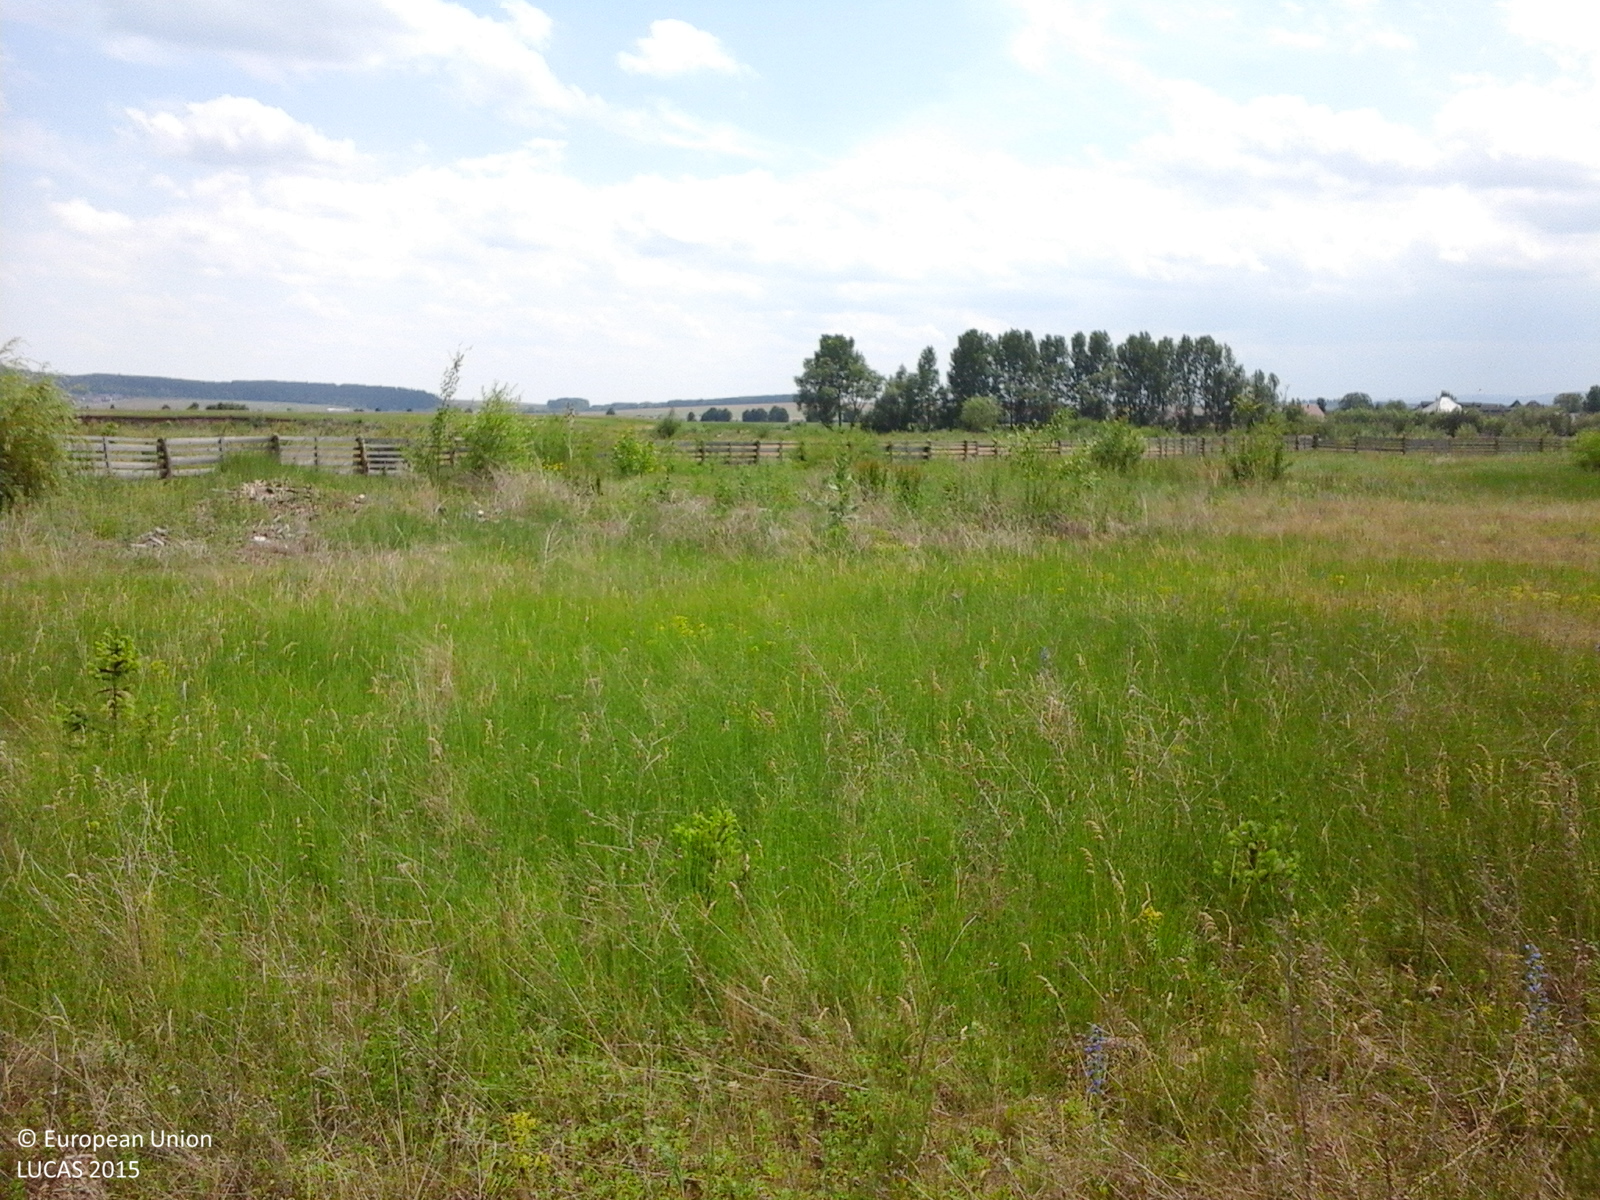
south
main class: Grassland
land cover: Spontaneously vegetated surfaces
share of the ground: > 75 %
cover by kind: herbaceous plants 100 %
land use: Fallow land
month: June
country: RO
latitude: 47.8194
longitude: 25.8472
